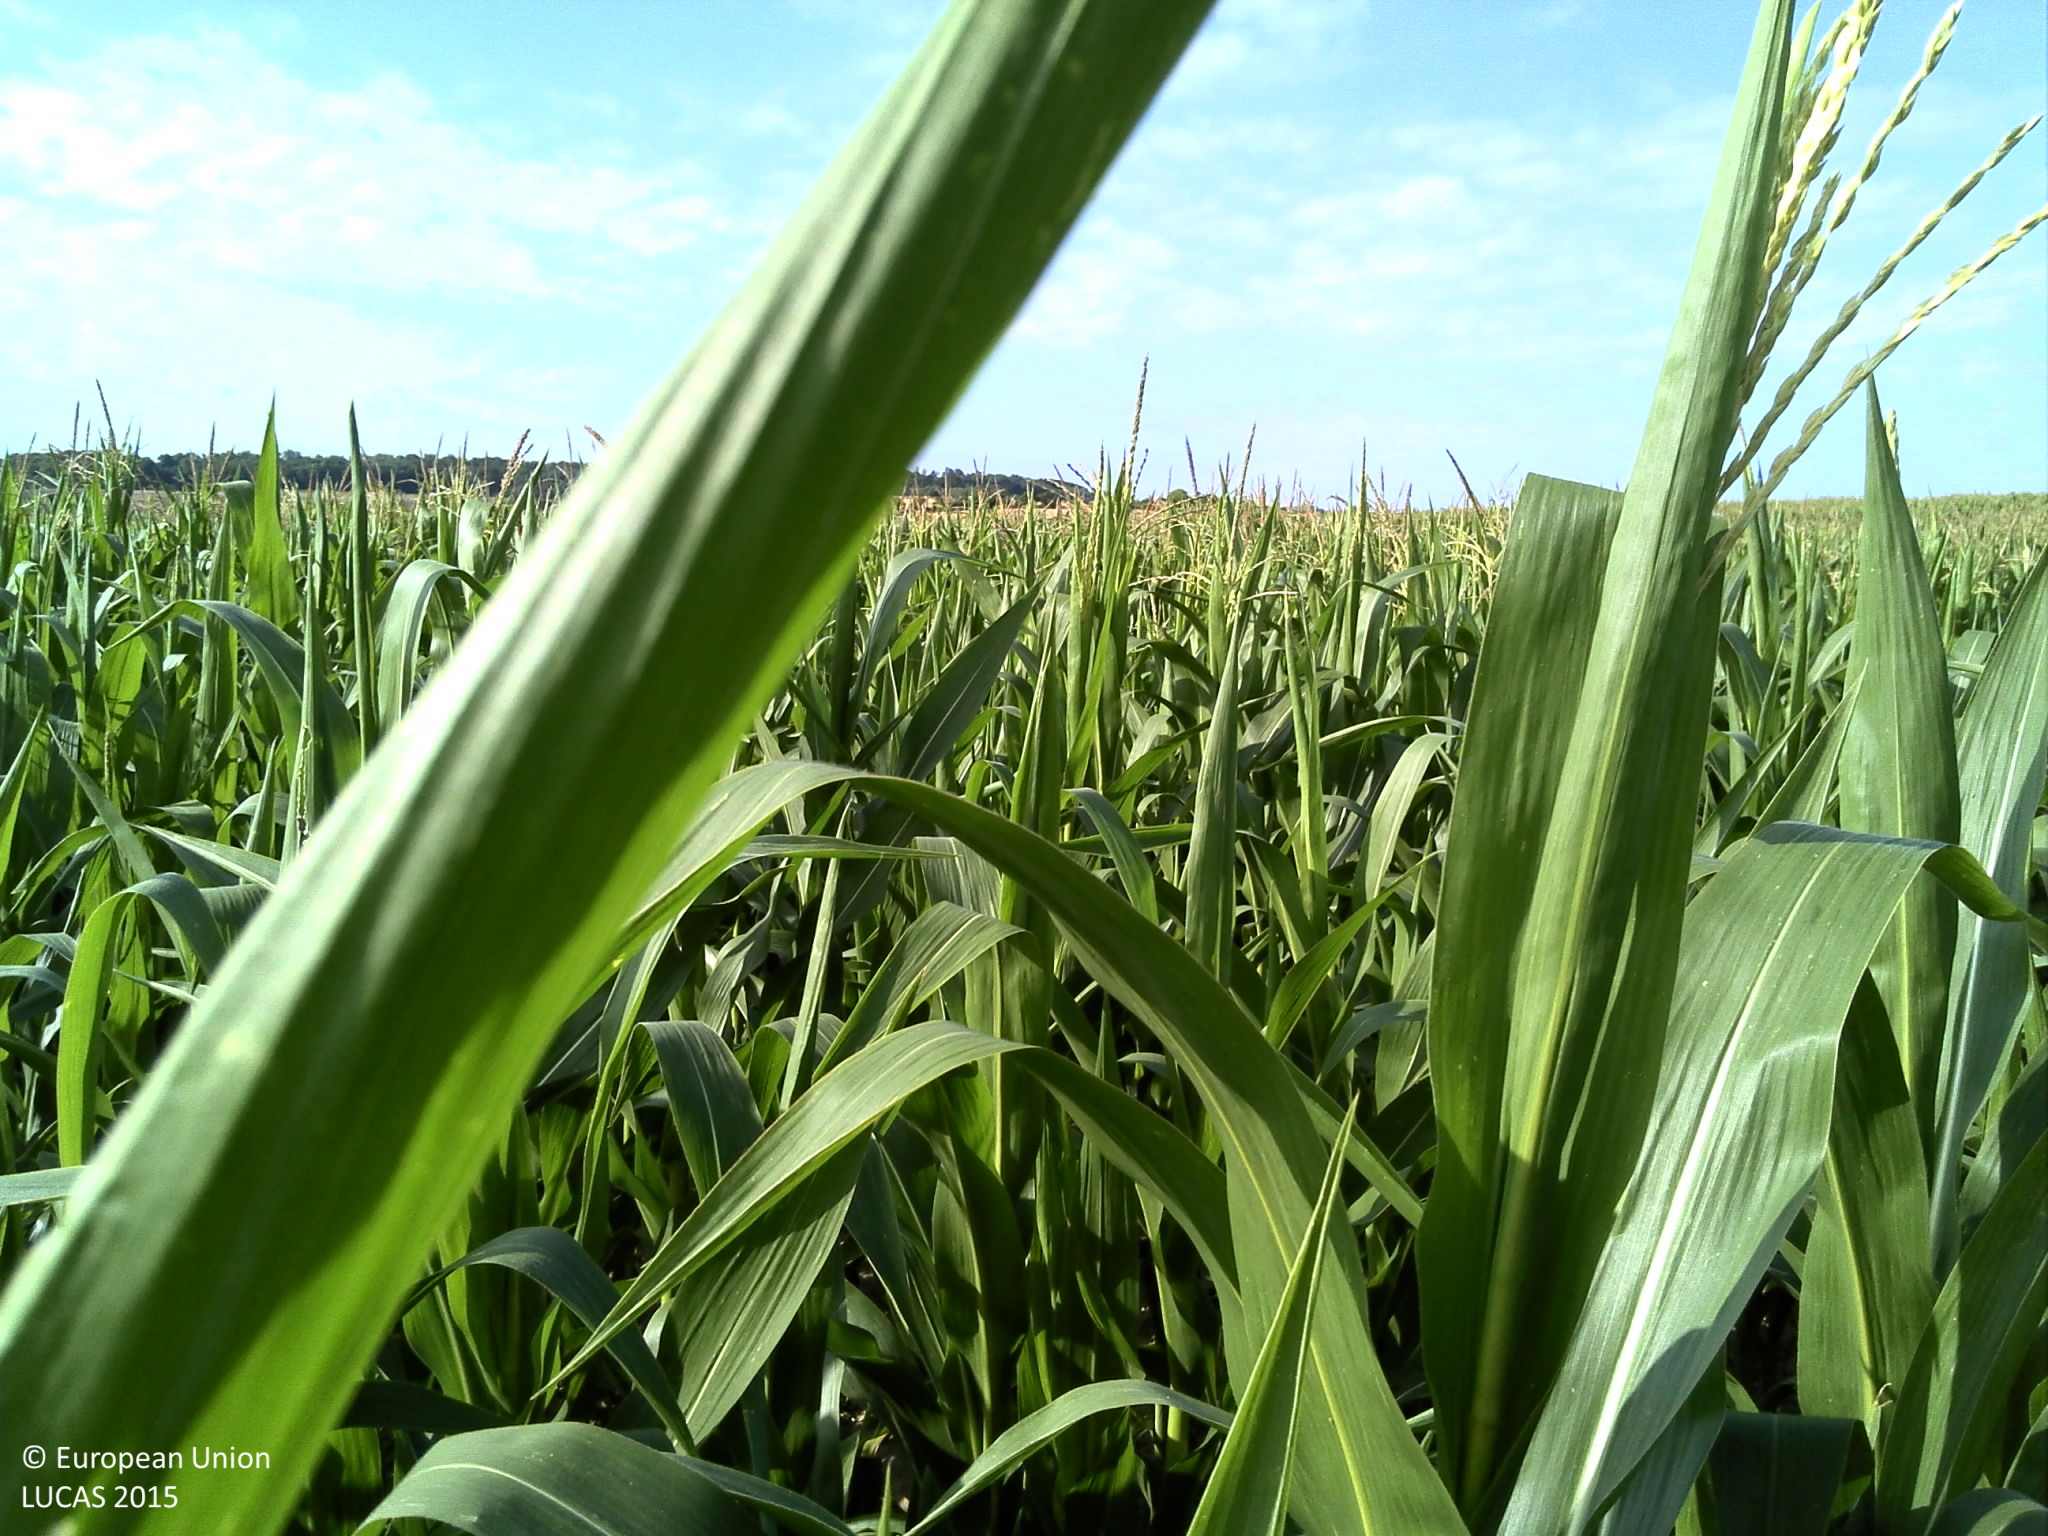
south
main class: Cropland
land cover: Maize
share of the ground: > 75 %
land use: Agriculture (excluding fallow land and kitchen gardens)
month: July
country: FR
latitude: 48.3583
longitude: 6.2620
